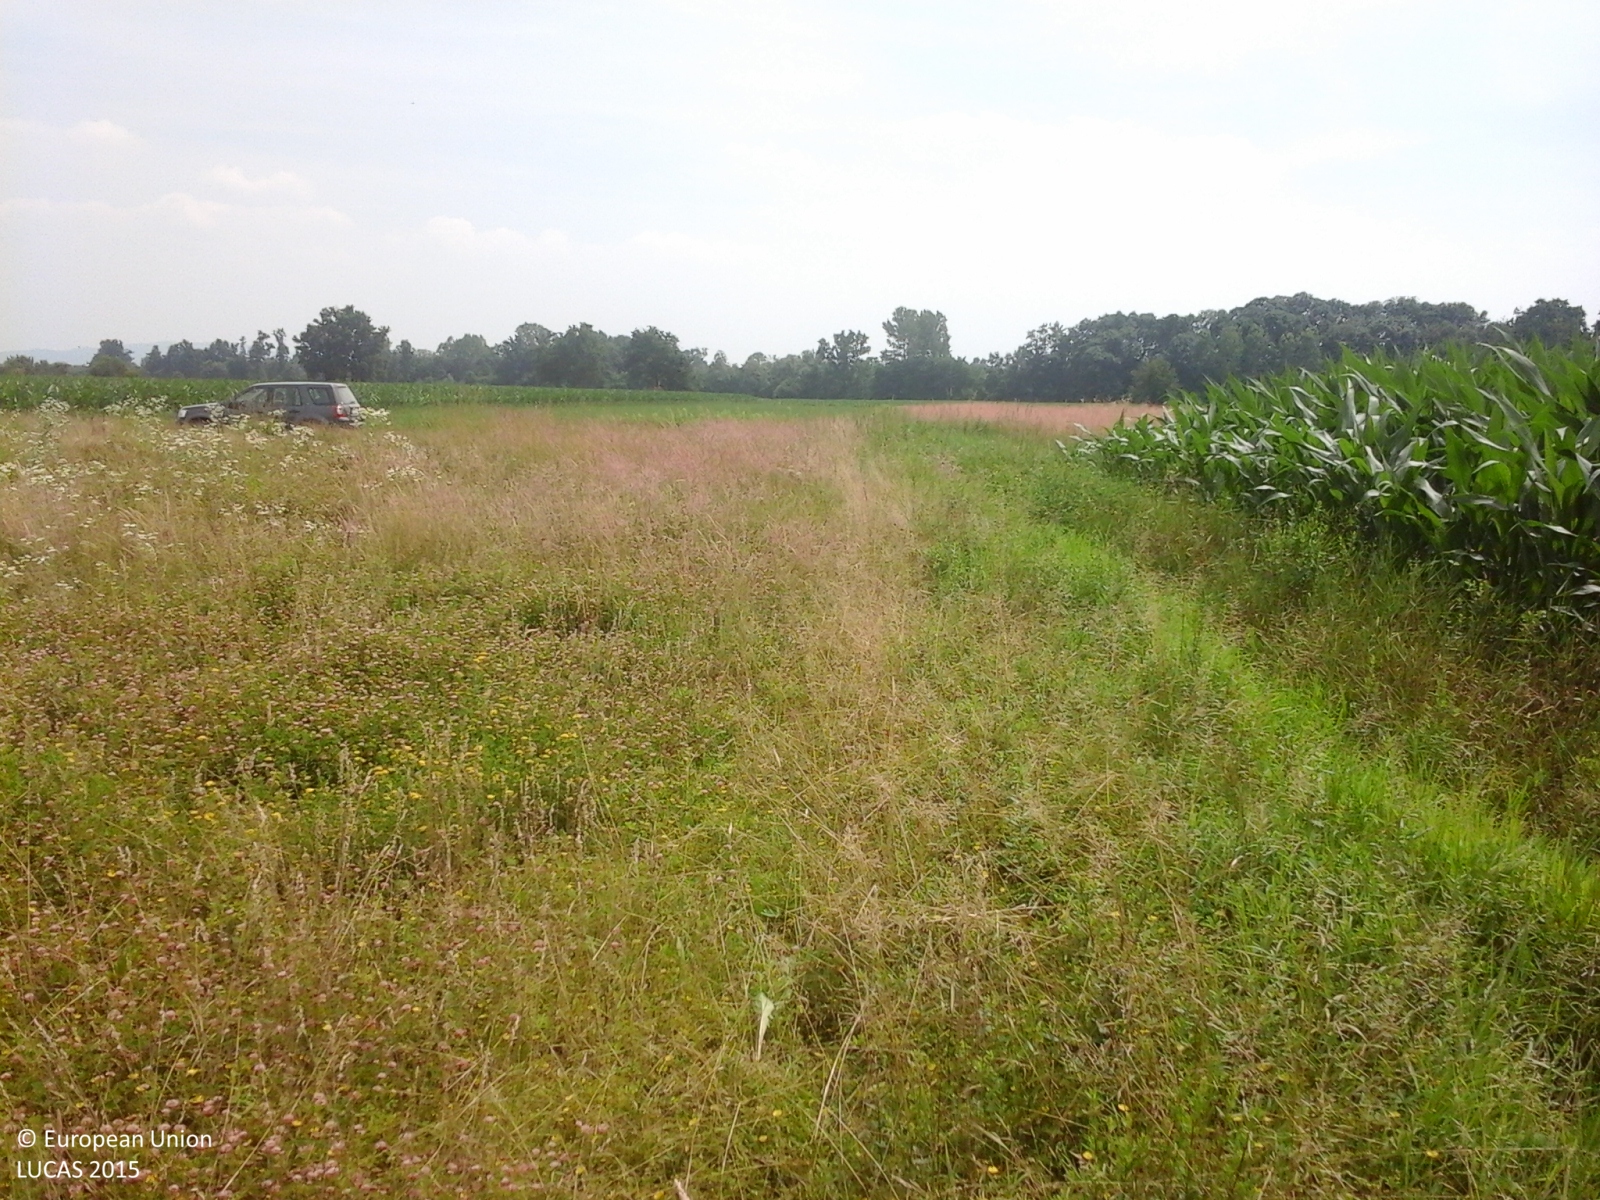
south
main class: Grassland
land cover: Spontaneously vegetated surfaces
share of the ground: > 75 %
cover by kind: herbaceous plants 100 %
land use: Agriculture (excluding fallow land and kitchen gardens)
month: June
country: IT
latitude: 45.2831
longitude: 7.7981
